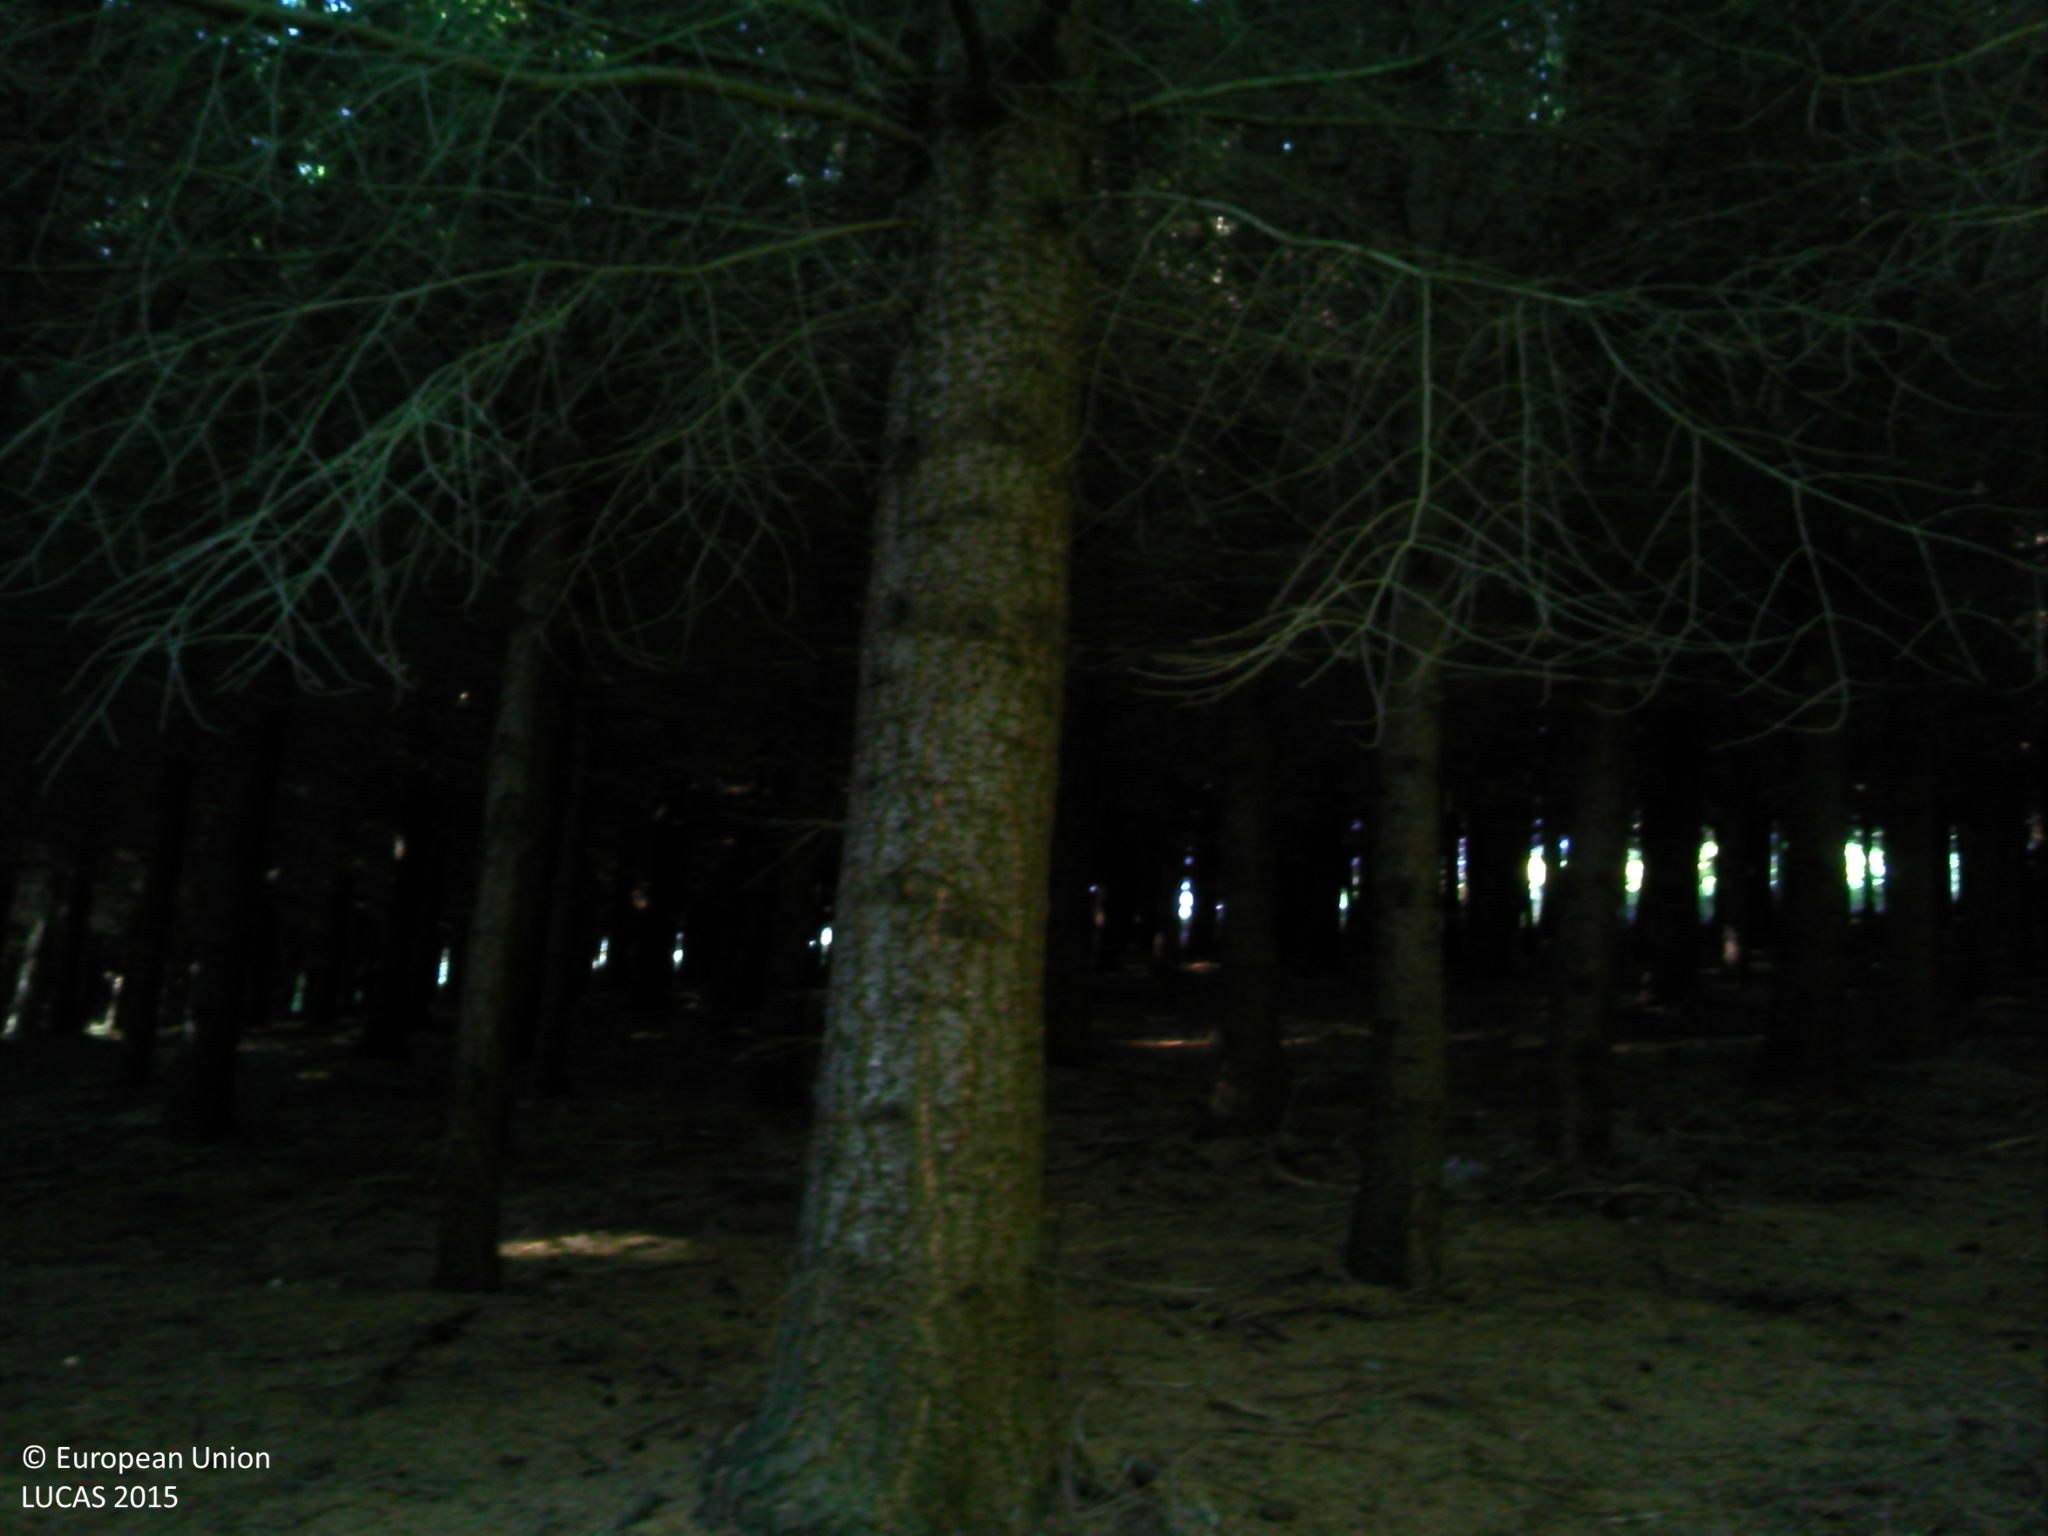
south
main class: Woodland
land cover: Spruce dominated coniferous woodland
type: alpine coniferous forest
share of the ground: > 75 %
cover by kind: coniferous forest trees 95 %, herbaceous plants 5 %
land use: Forestry
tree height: > 5 m
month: September
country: FR
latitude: 45.4190
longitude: 4.5729
